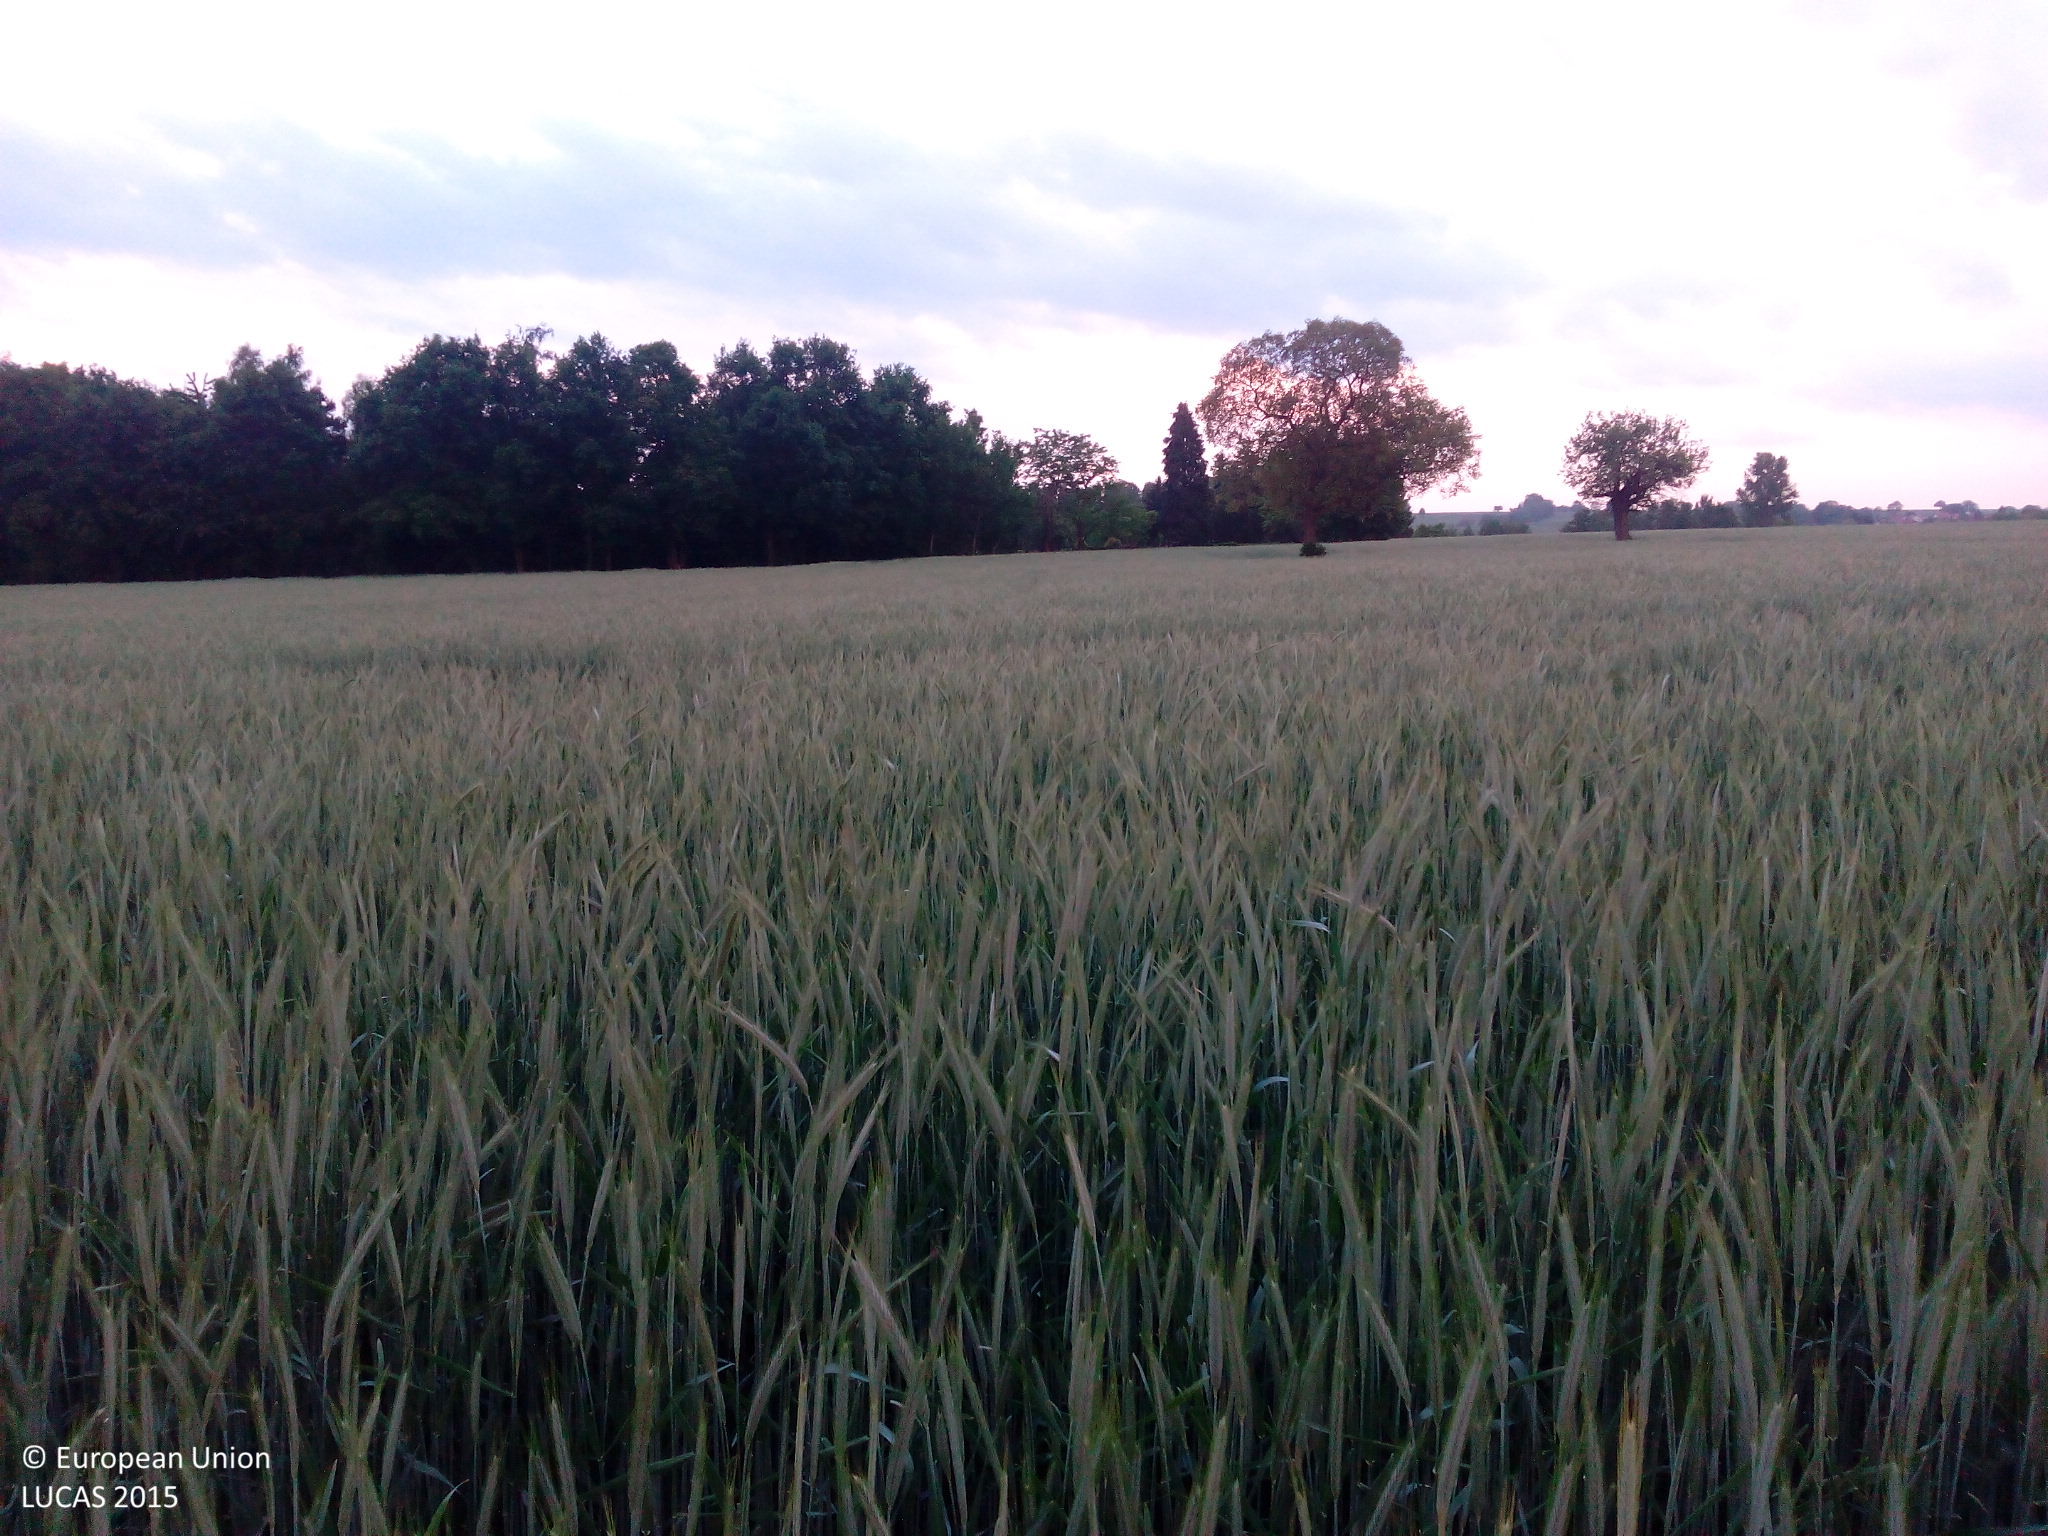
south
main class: Cropland
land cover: Rye
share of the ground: > 75 %
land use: Agriculture (excluding fallow land and kitchen gardens)
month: May
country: DE
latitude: 49.1065
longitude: 8.0692
